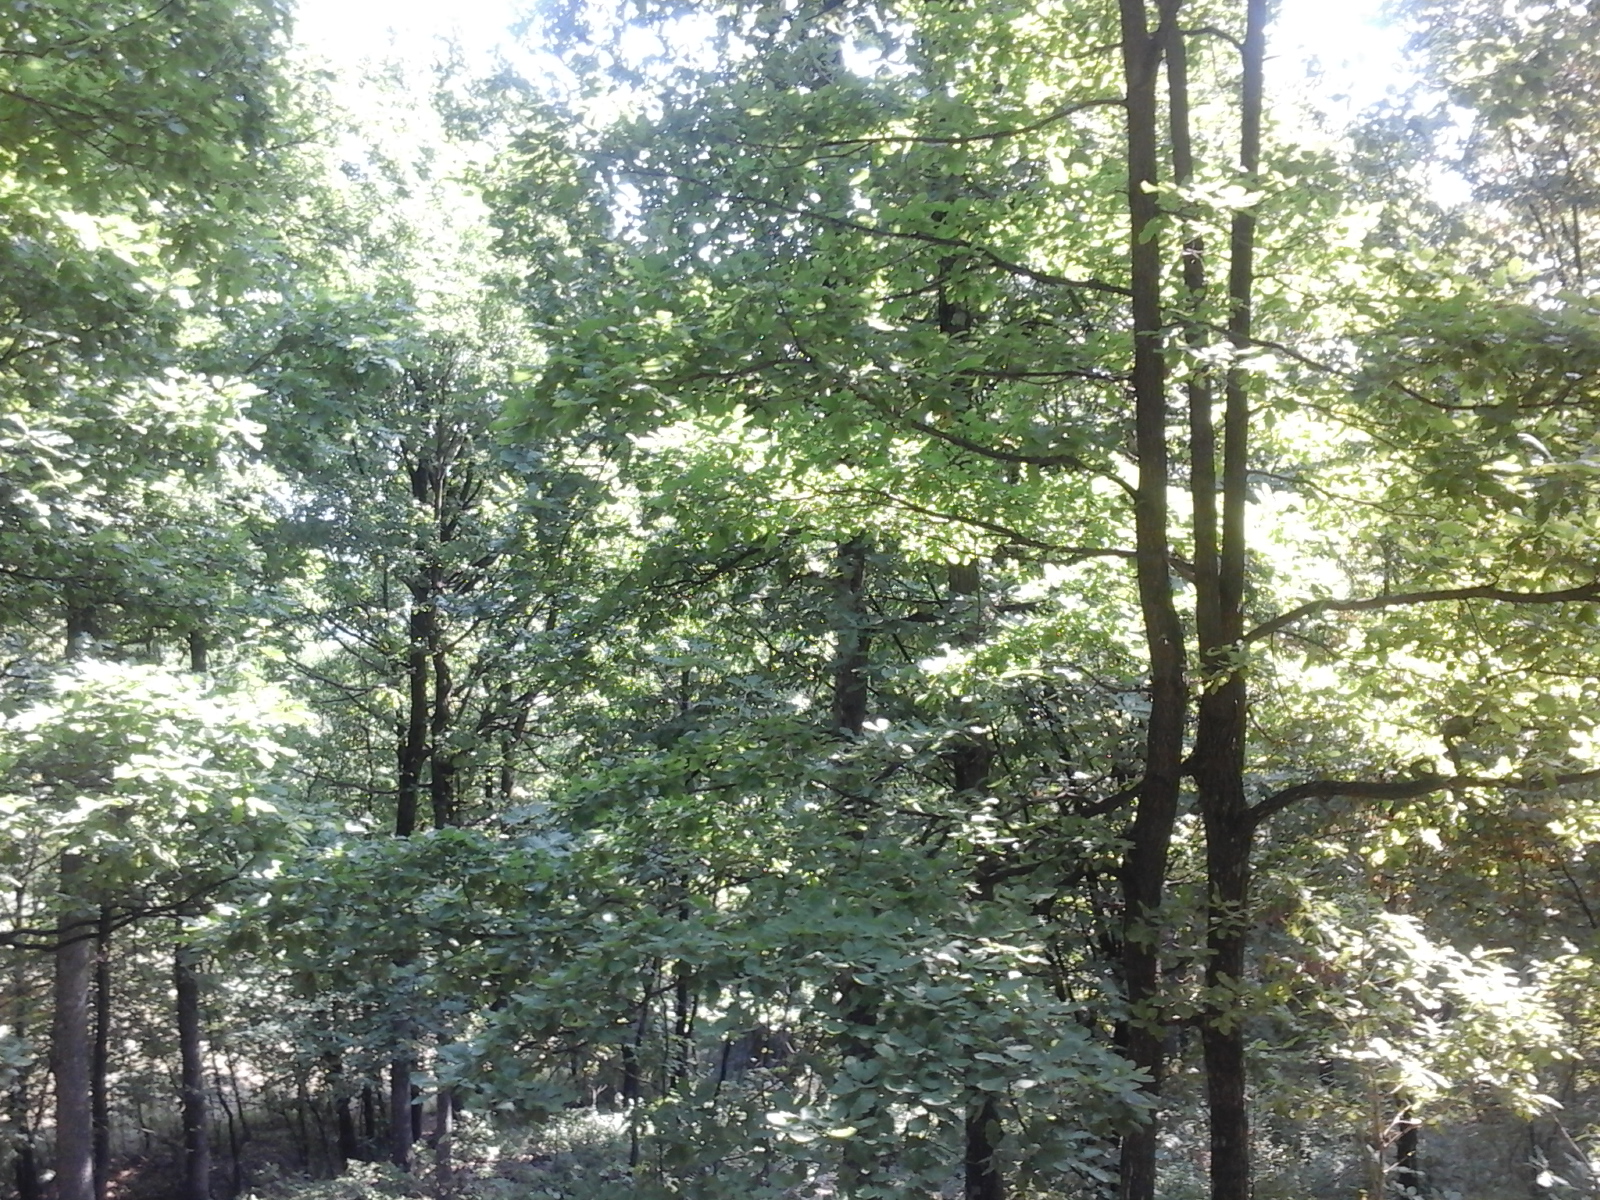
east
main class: Woodland
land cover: Broadleaved woodland
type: acidophilous oak and oak-birch forest
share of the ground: > 75 %
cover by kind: broadleaved forest trees 100 %
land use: Forestry
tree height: > 5 m
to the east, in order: Broadleaved woodland
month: August
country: RO
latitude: 44.8302
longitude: 23.9390
